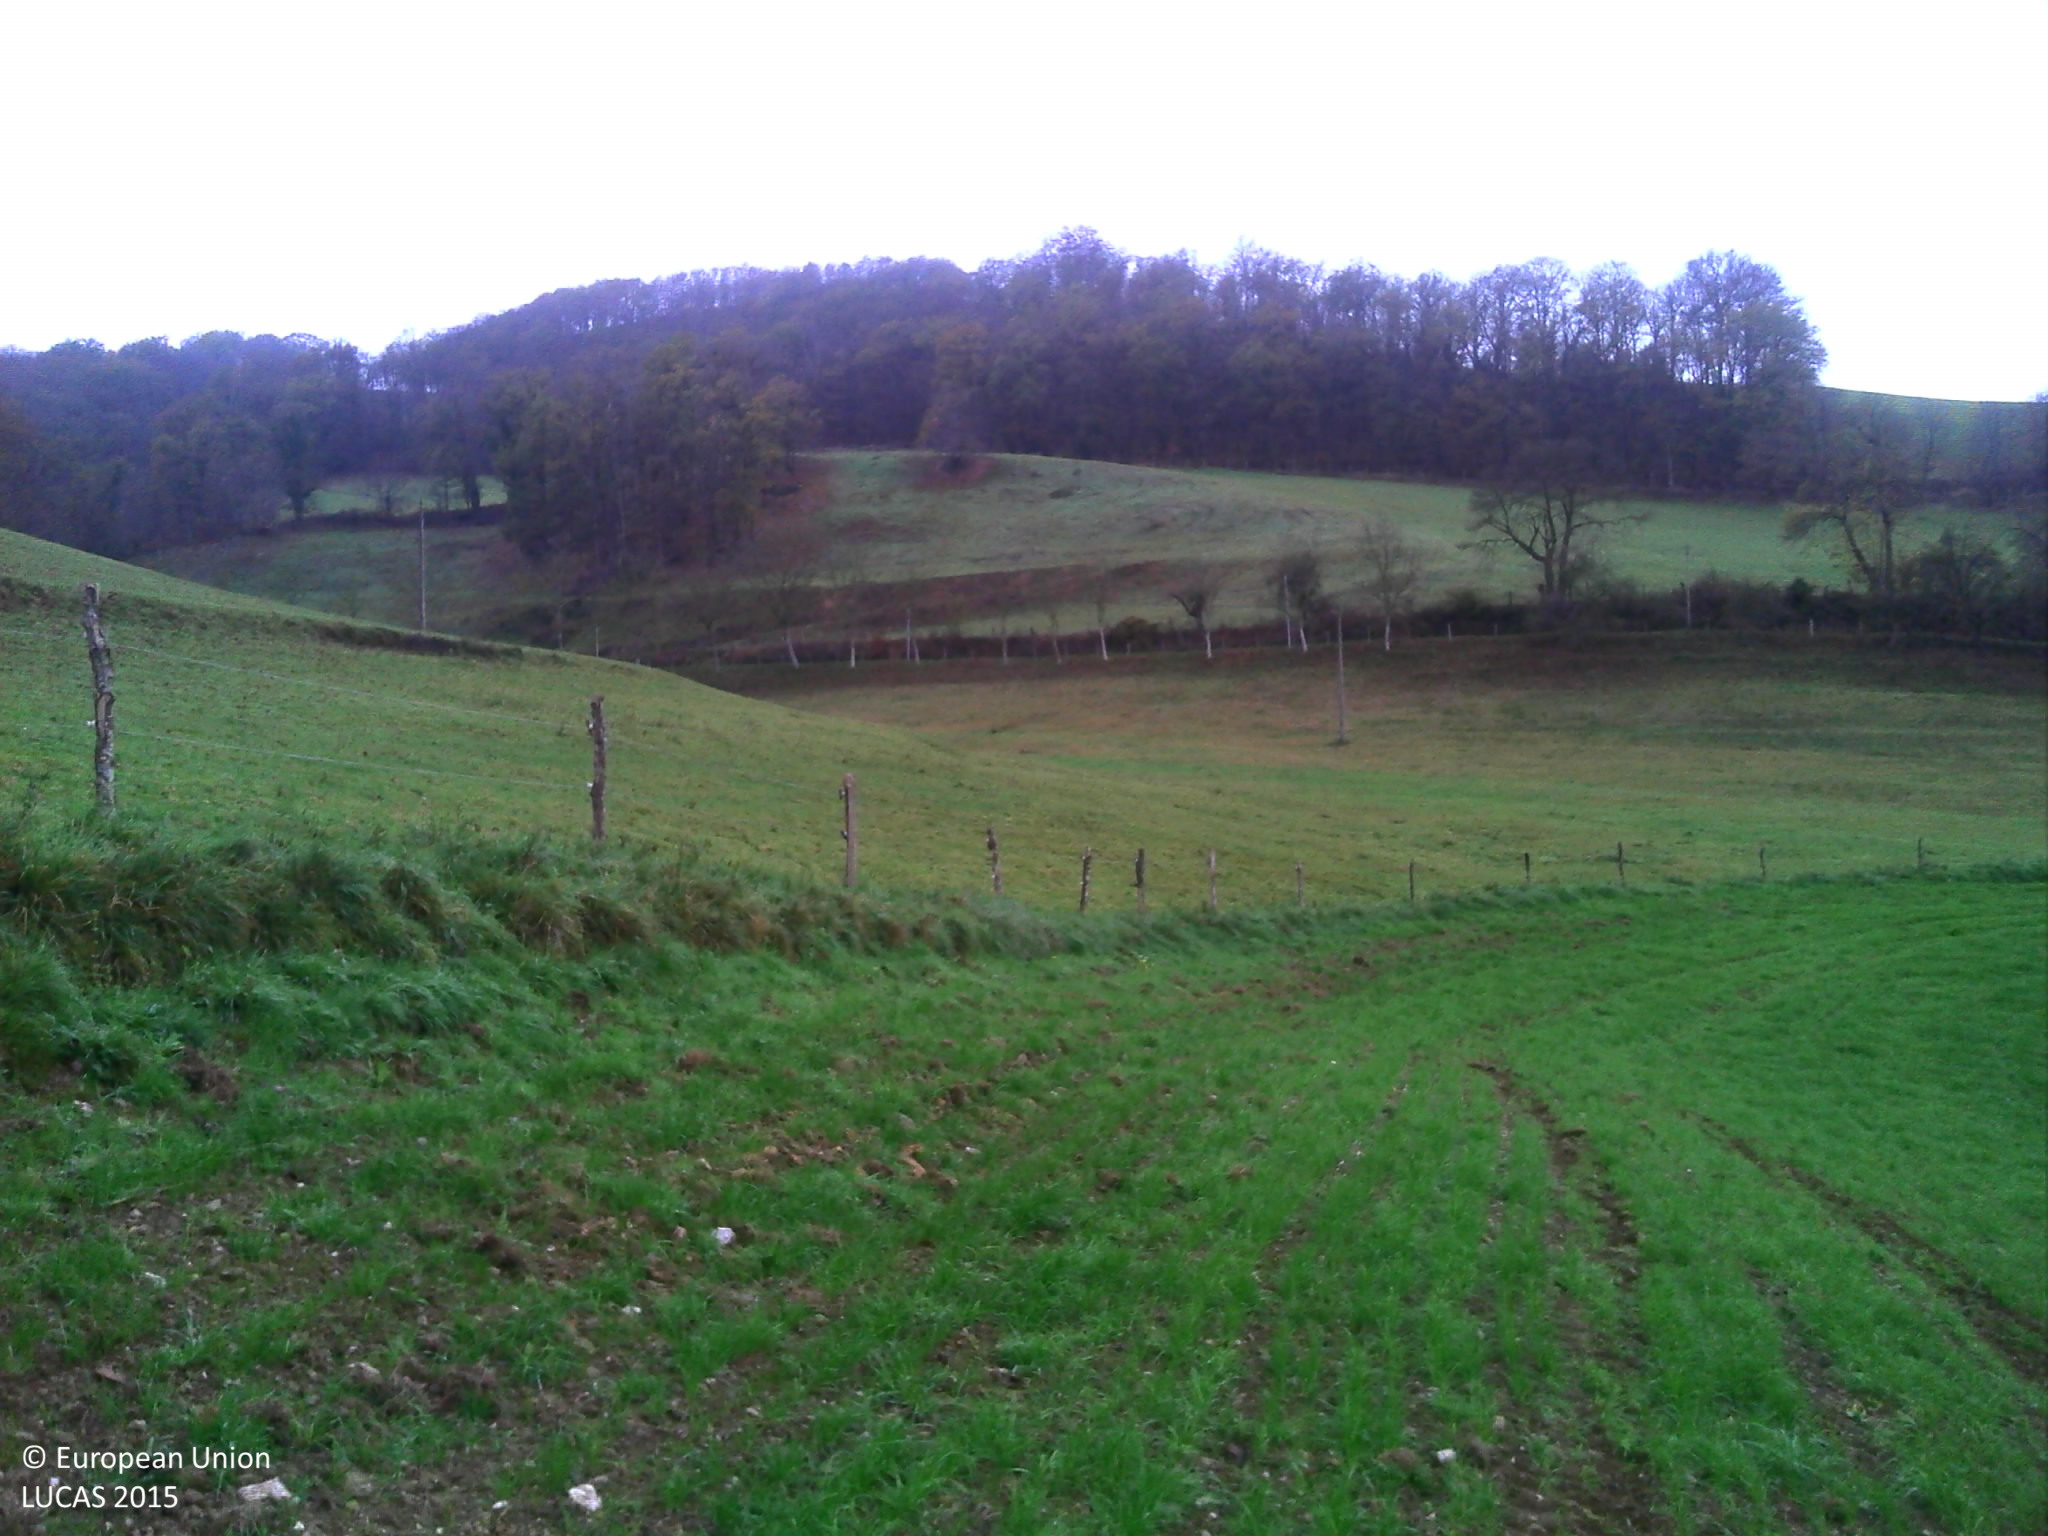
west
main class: Cropland
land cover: Temporary grasslands
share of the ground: > 75 %
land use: Agriculture (excluding fallow land and kitchen gardens)
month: November
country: FR
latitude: 43.9192
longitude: 2.5453
